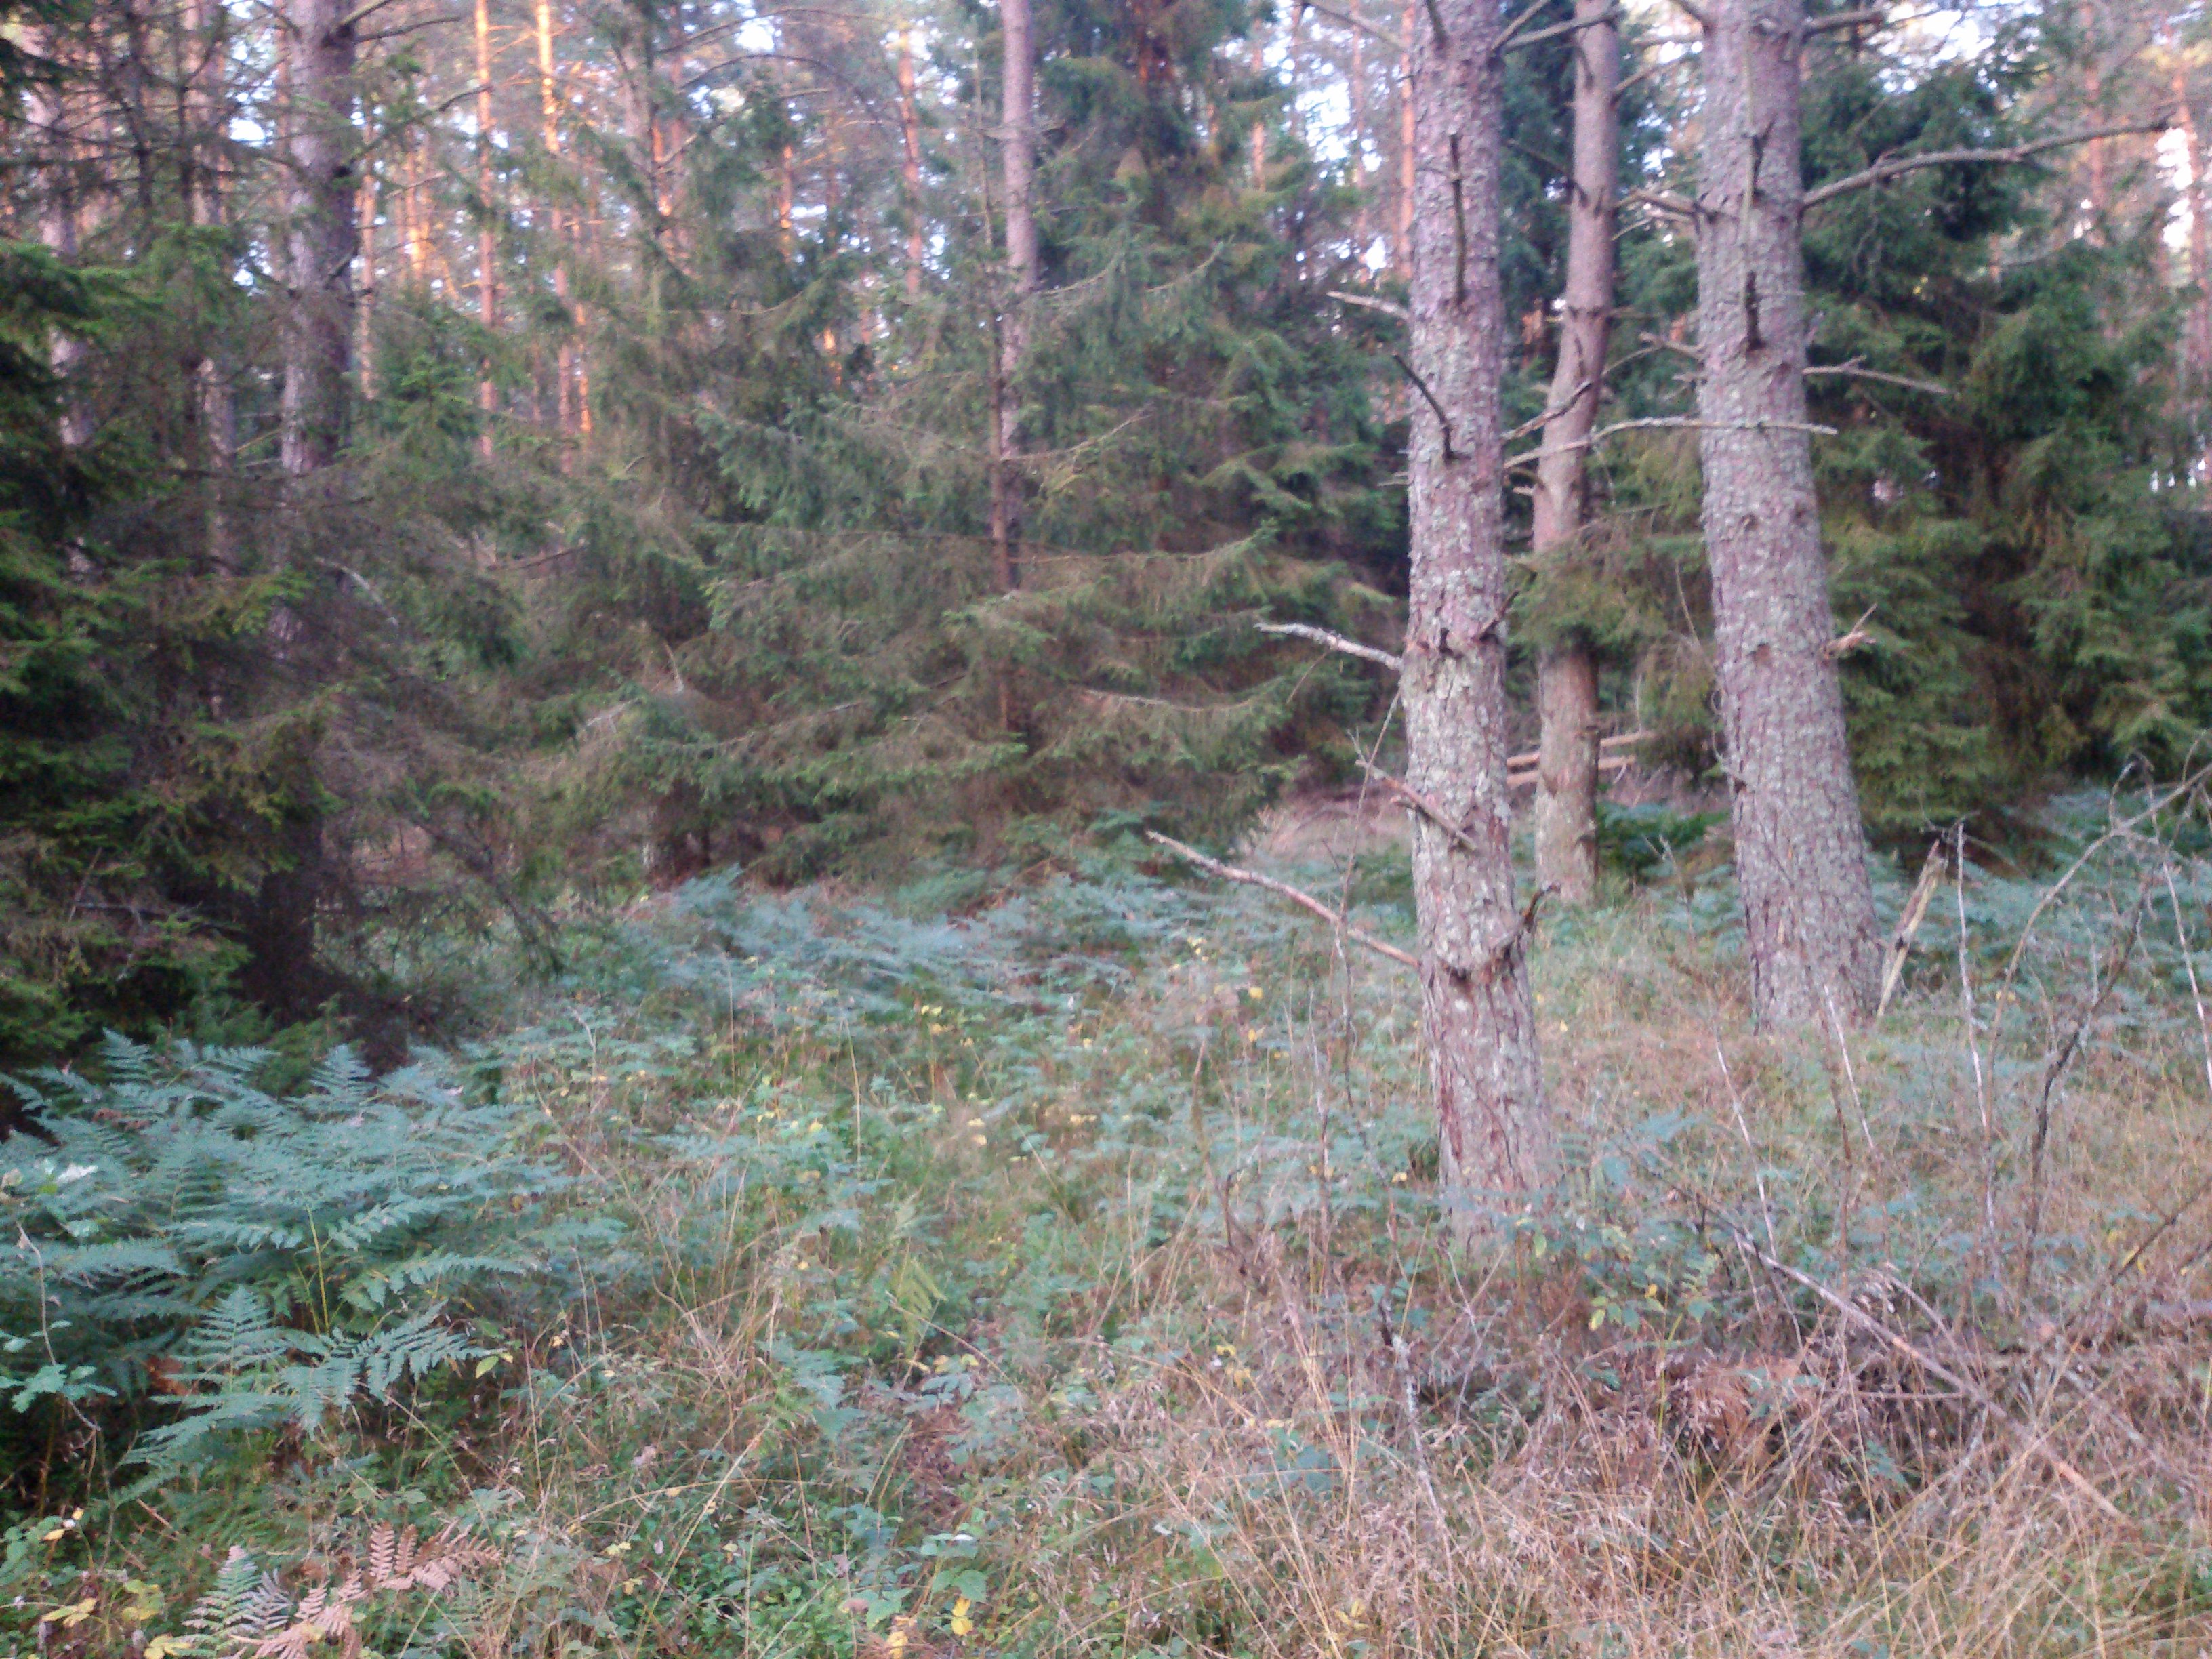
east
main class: Woodland
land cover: Pine dominated coniferous woodland
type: hemiboreal forest and nemoral coniferous forest and mixed broadleaved-coniferous forest
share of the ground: 50 - 75 %
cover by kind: coniferous forest trees 65 %, herbaceous plants 25 %, shrubs 5 %, lichens and mosses 5 %
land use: Forestry
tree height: > 5 m
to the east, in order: Pine dominated coniferous woodland; Tracks; Pine dominated mixed woodland; Pine dominated coniferous woodland
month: August
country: PL
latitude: 53.8035
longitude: 17.1613
